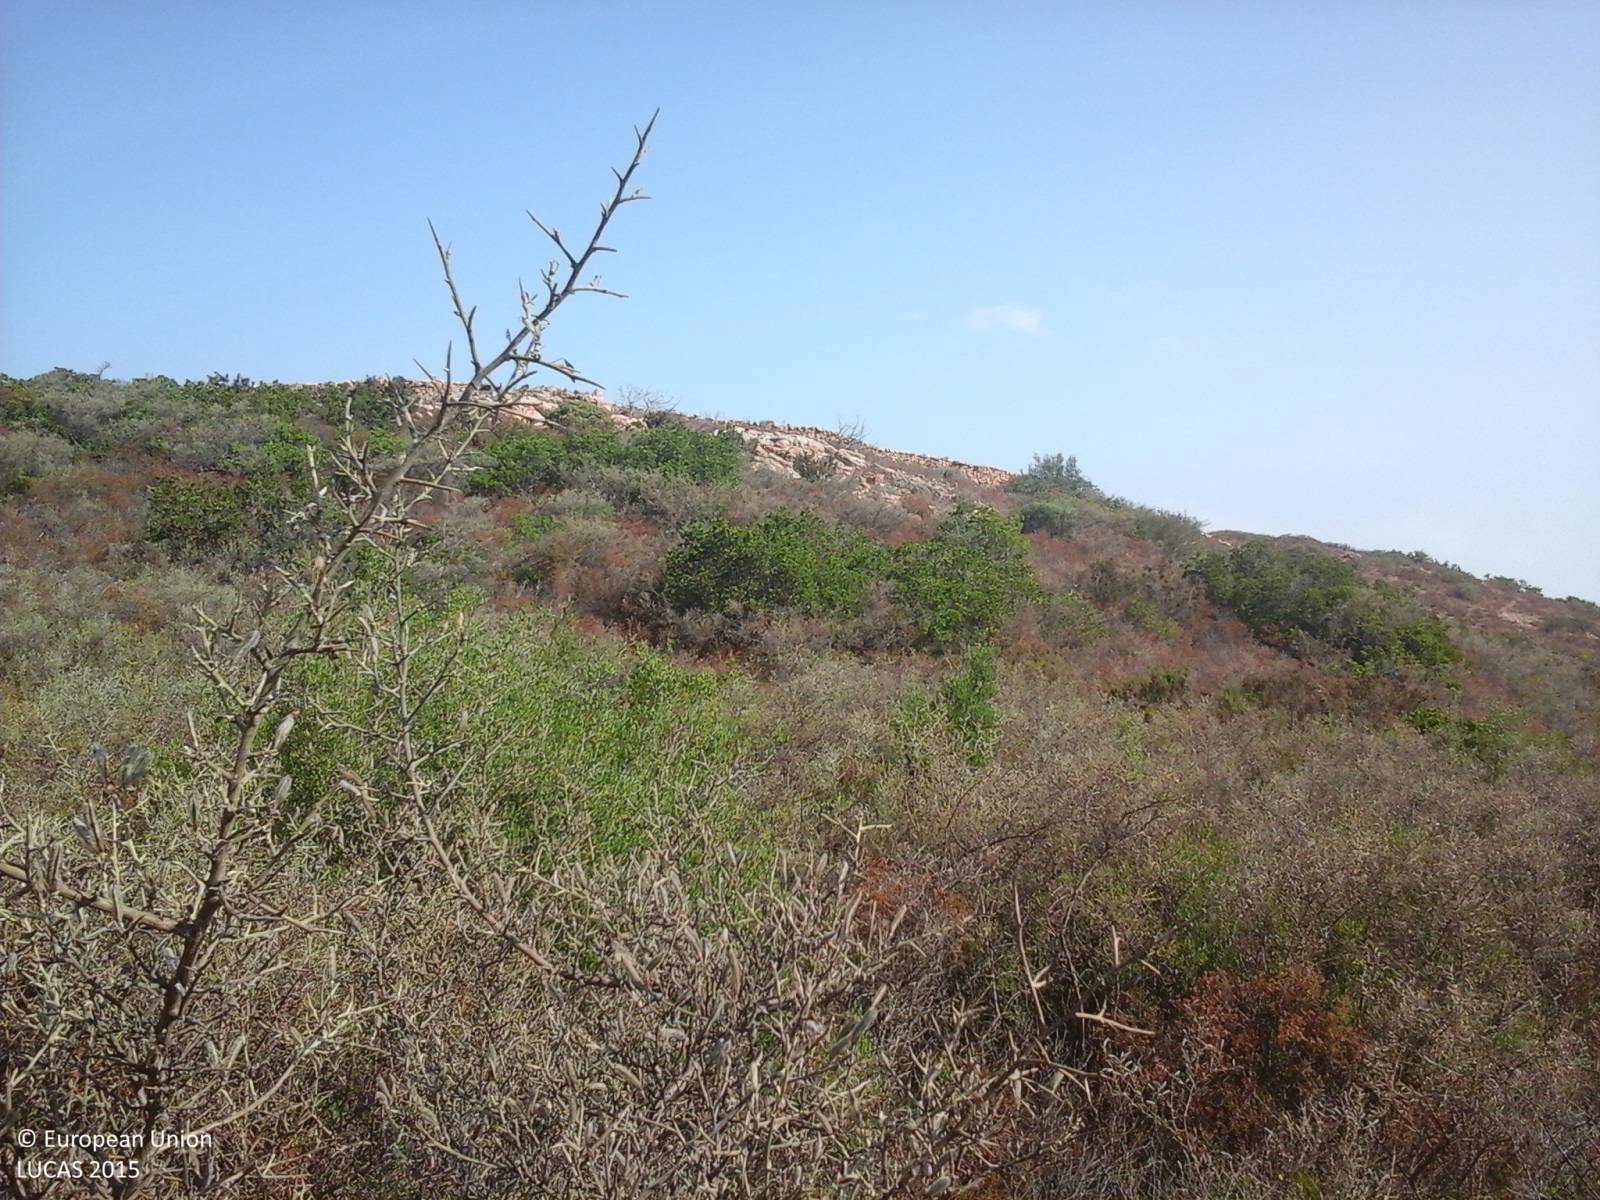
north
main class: Shrubland
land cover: Shrubland without tree cover
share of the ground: > 75 %
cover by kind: shrubs 95 %, unconsolidated bare surface 5 %
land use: Semi-natural and natural areas not in use
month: July
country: IT
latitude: 40.8638
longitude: 9.6340
